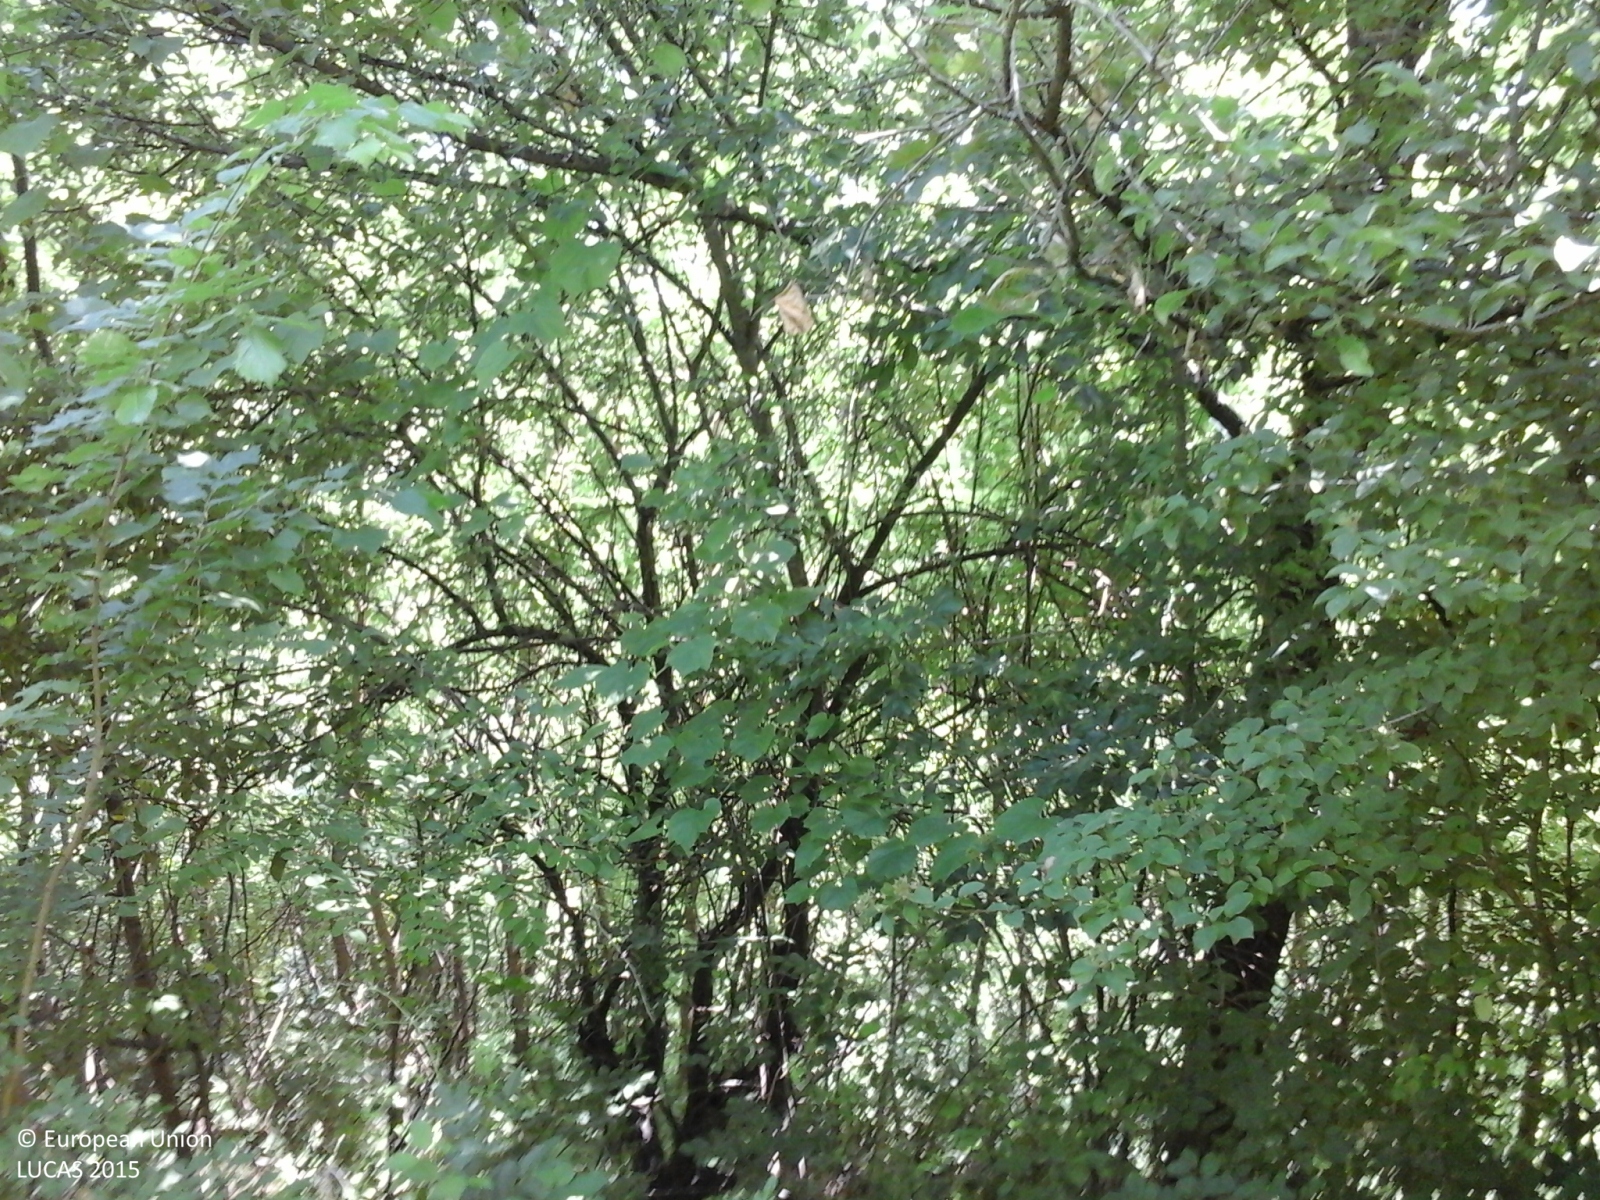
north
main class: Woodland
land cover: Broadleaved woodland
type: mesophytic deciduous forest
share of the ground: > 75 %
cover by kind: broadleaved forest trees 85 %, shrubs 10 %, herbaceous plants 5 %
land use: Forestry
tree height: > 5 m
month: June
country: IT
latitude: 44.6437
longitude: 8.3266
